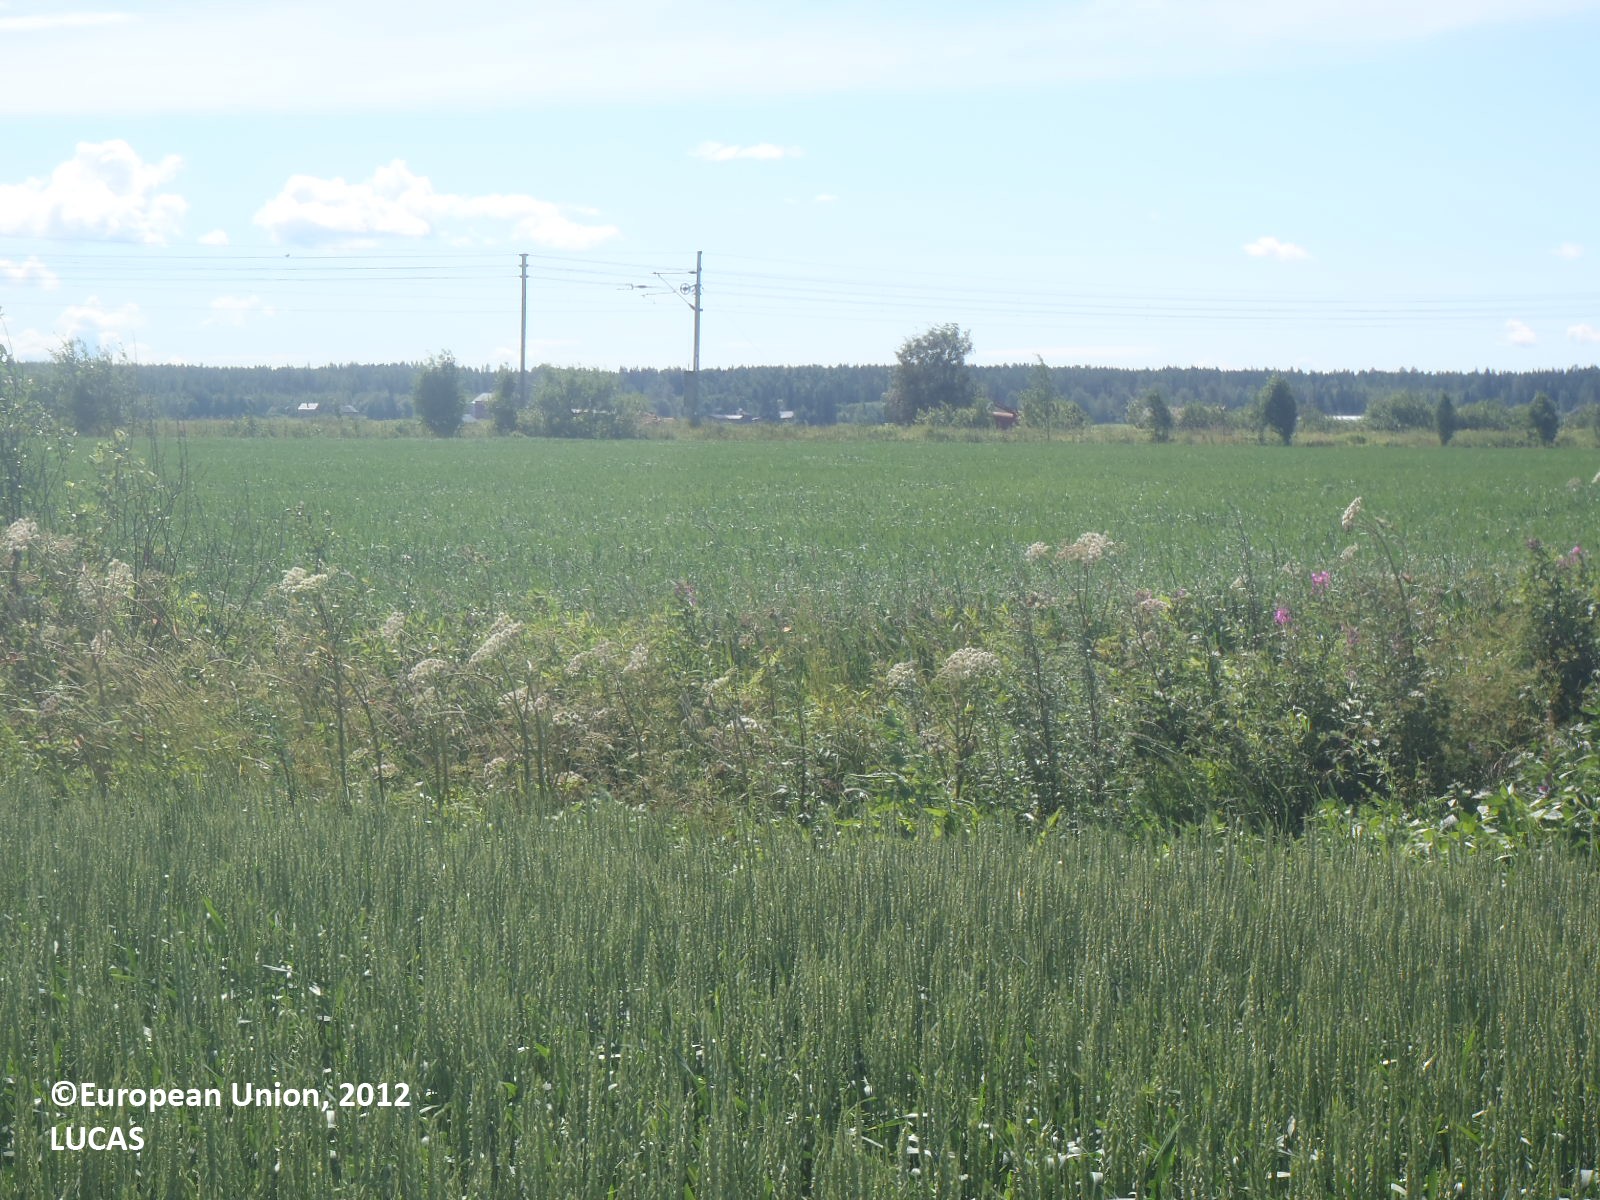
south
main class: Cropland
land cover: Common wheat
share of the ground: > 75 %
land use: Agriculture (excluding fallow land and kitchen gardens)
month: July
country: FI
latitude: 61.2032
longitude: 21.9496
